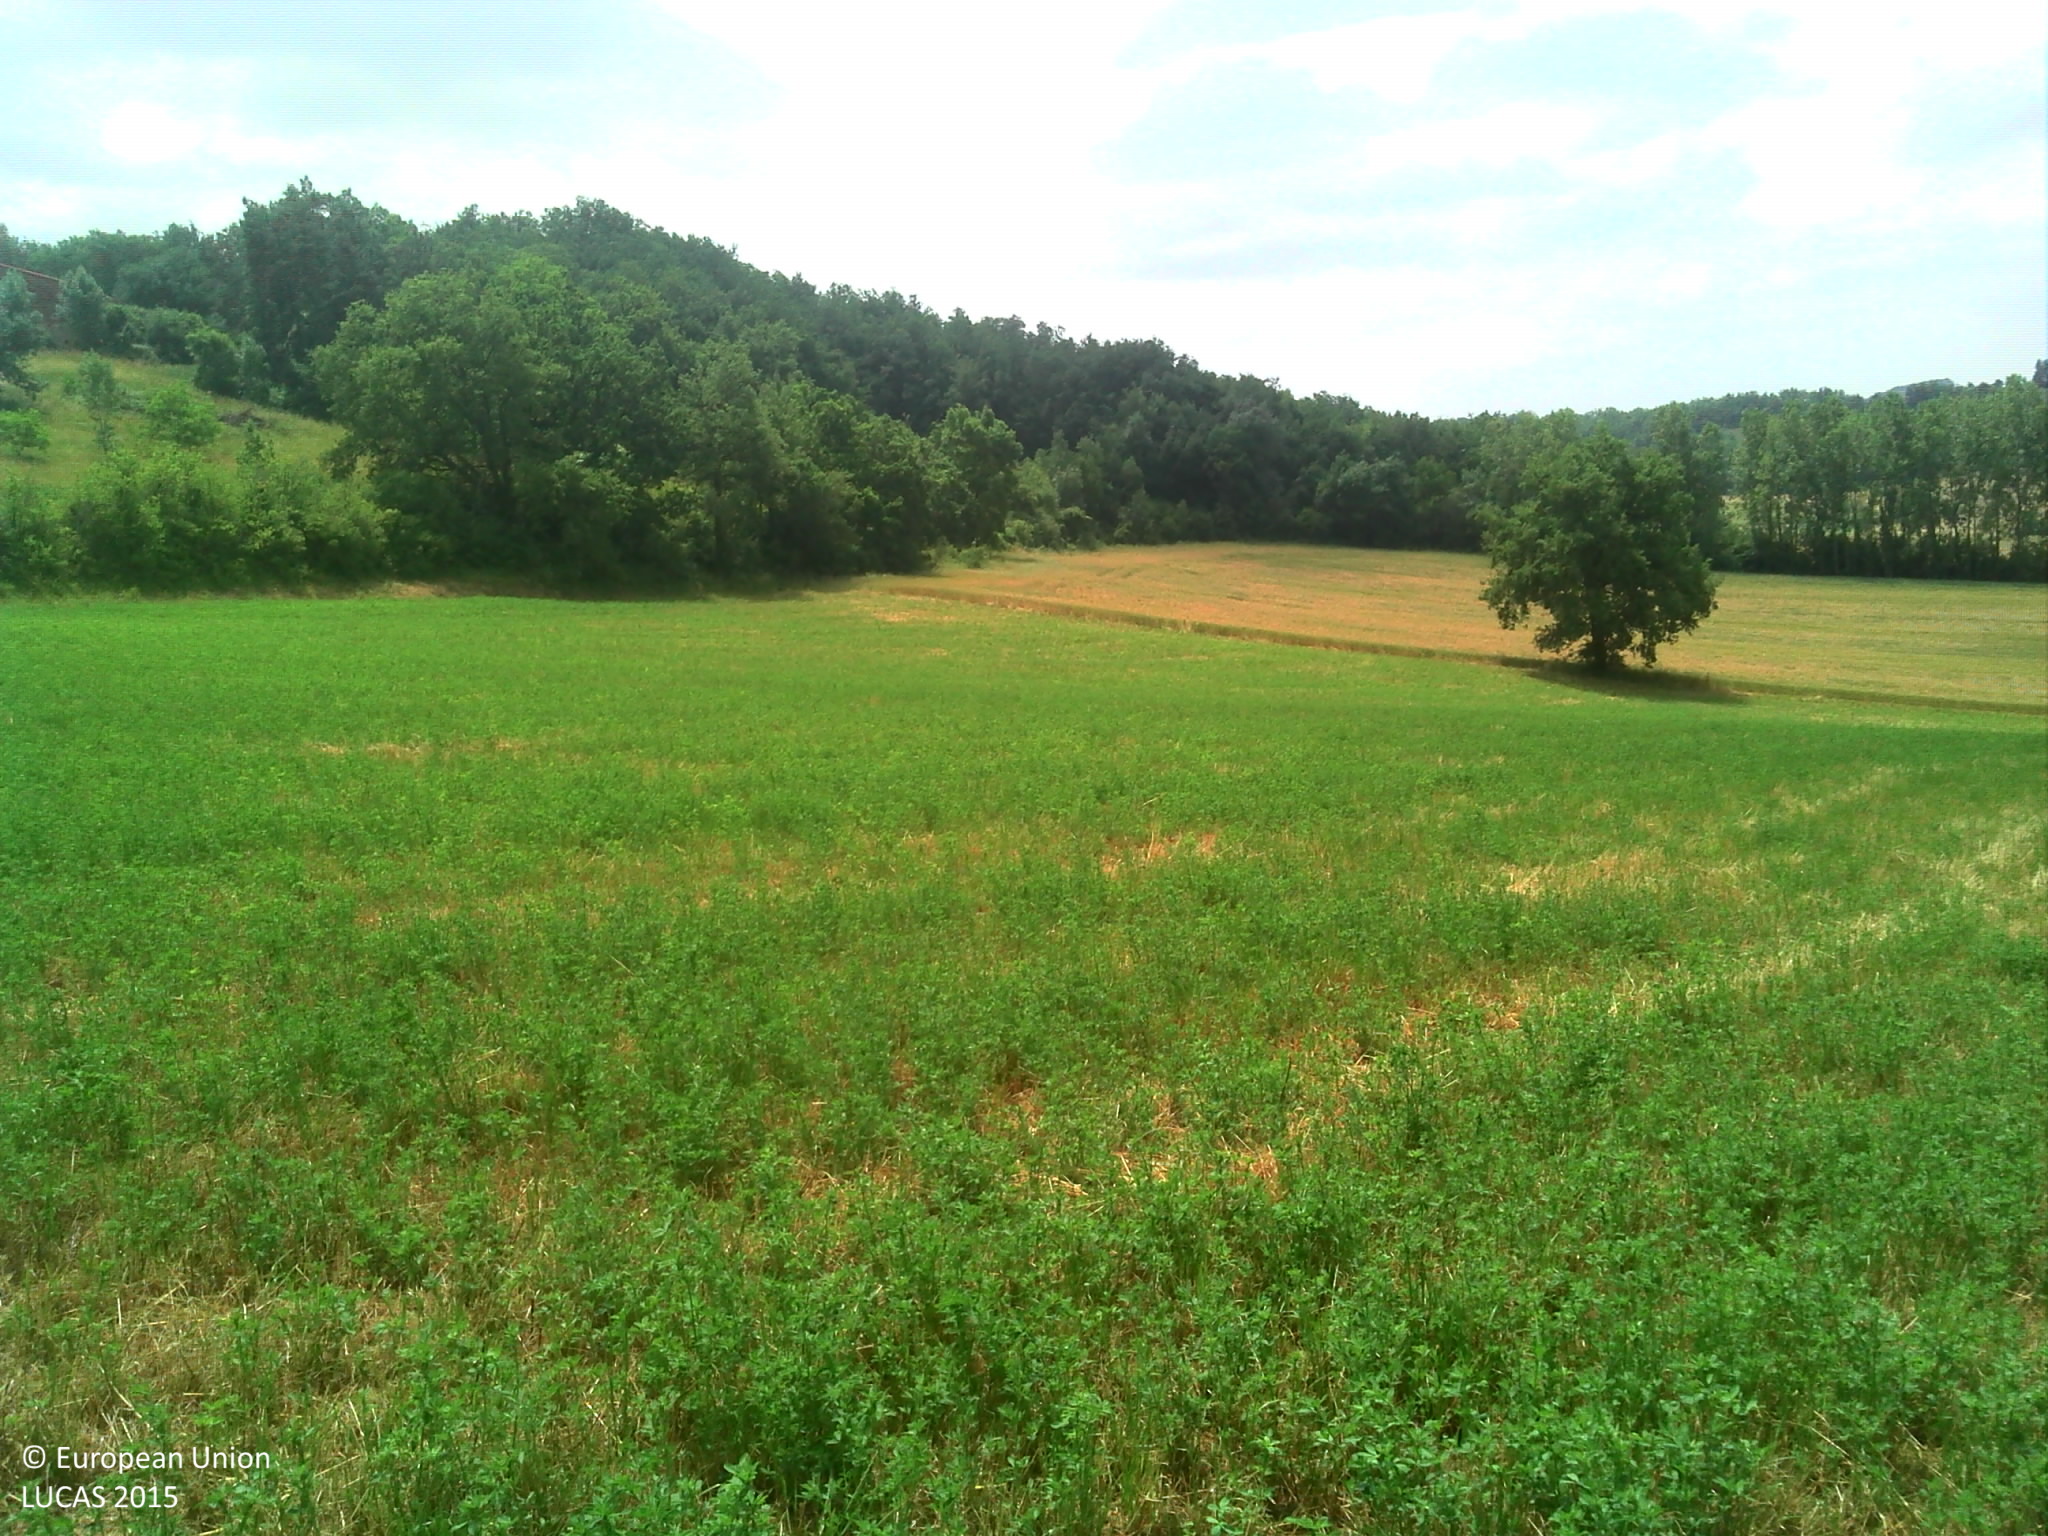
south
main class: Cropland
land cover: Lucerne
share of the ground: > 75 %
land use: Agriculture (excluding fallow land and kitchen gardens)
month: June
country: FR
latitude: 43.7605
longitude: 2.1172
